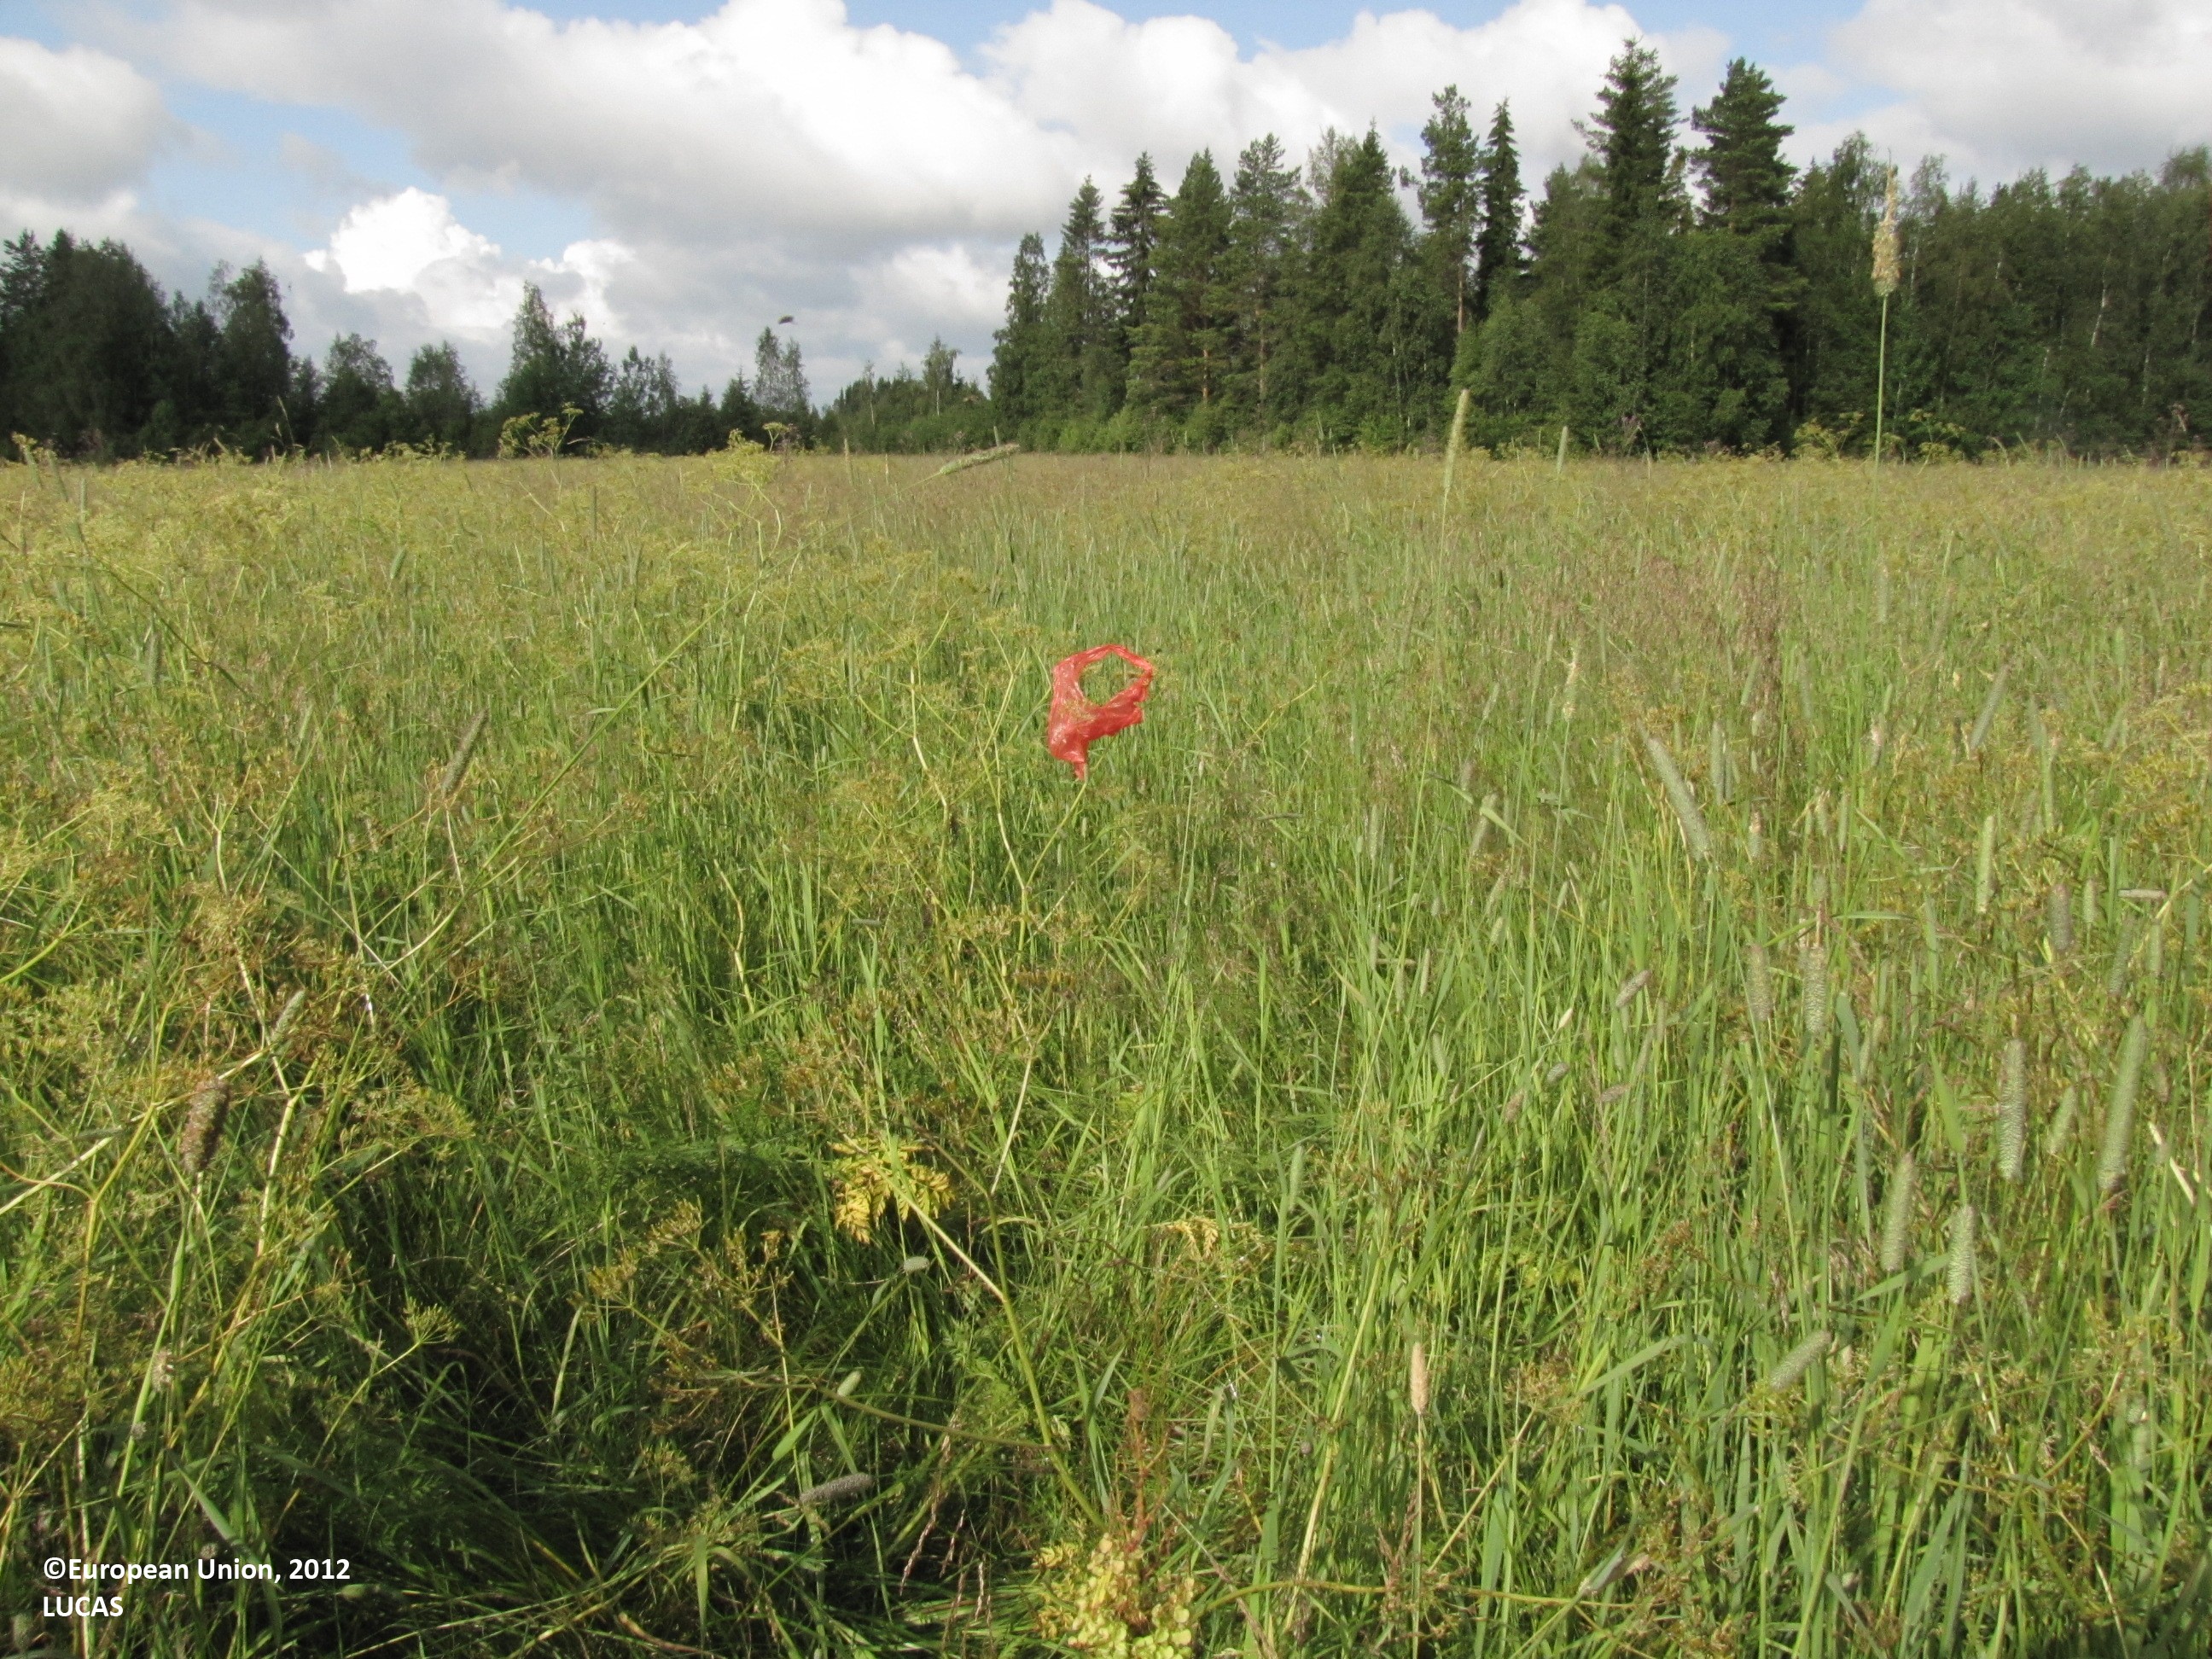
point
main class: Grassland
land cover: Spontaneously vegetated surfaces
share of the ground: > 75 %
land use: Agriculture (excluding fallow land and kitchen gardens)
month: July
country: FI
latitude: 62.6860
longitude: 23.0128
